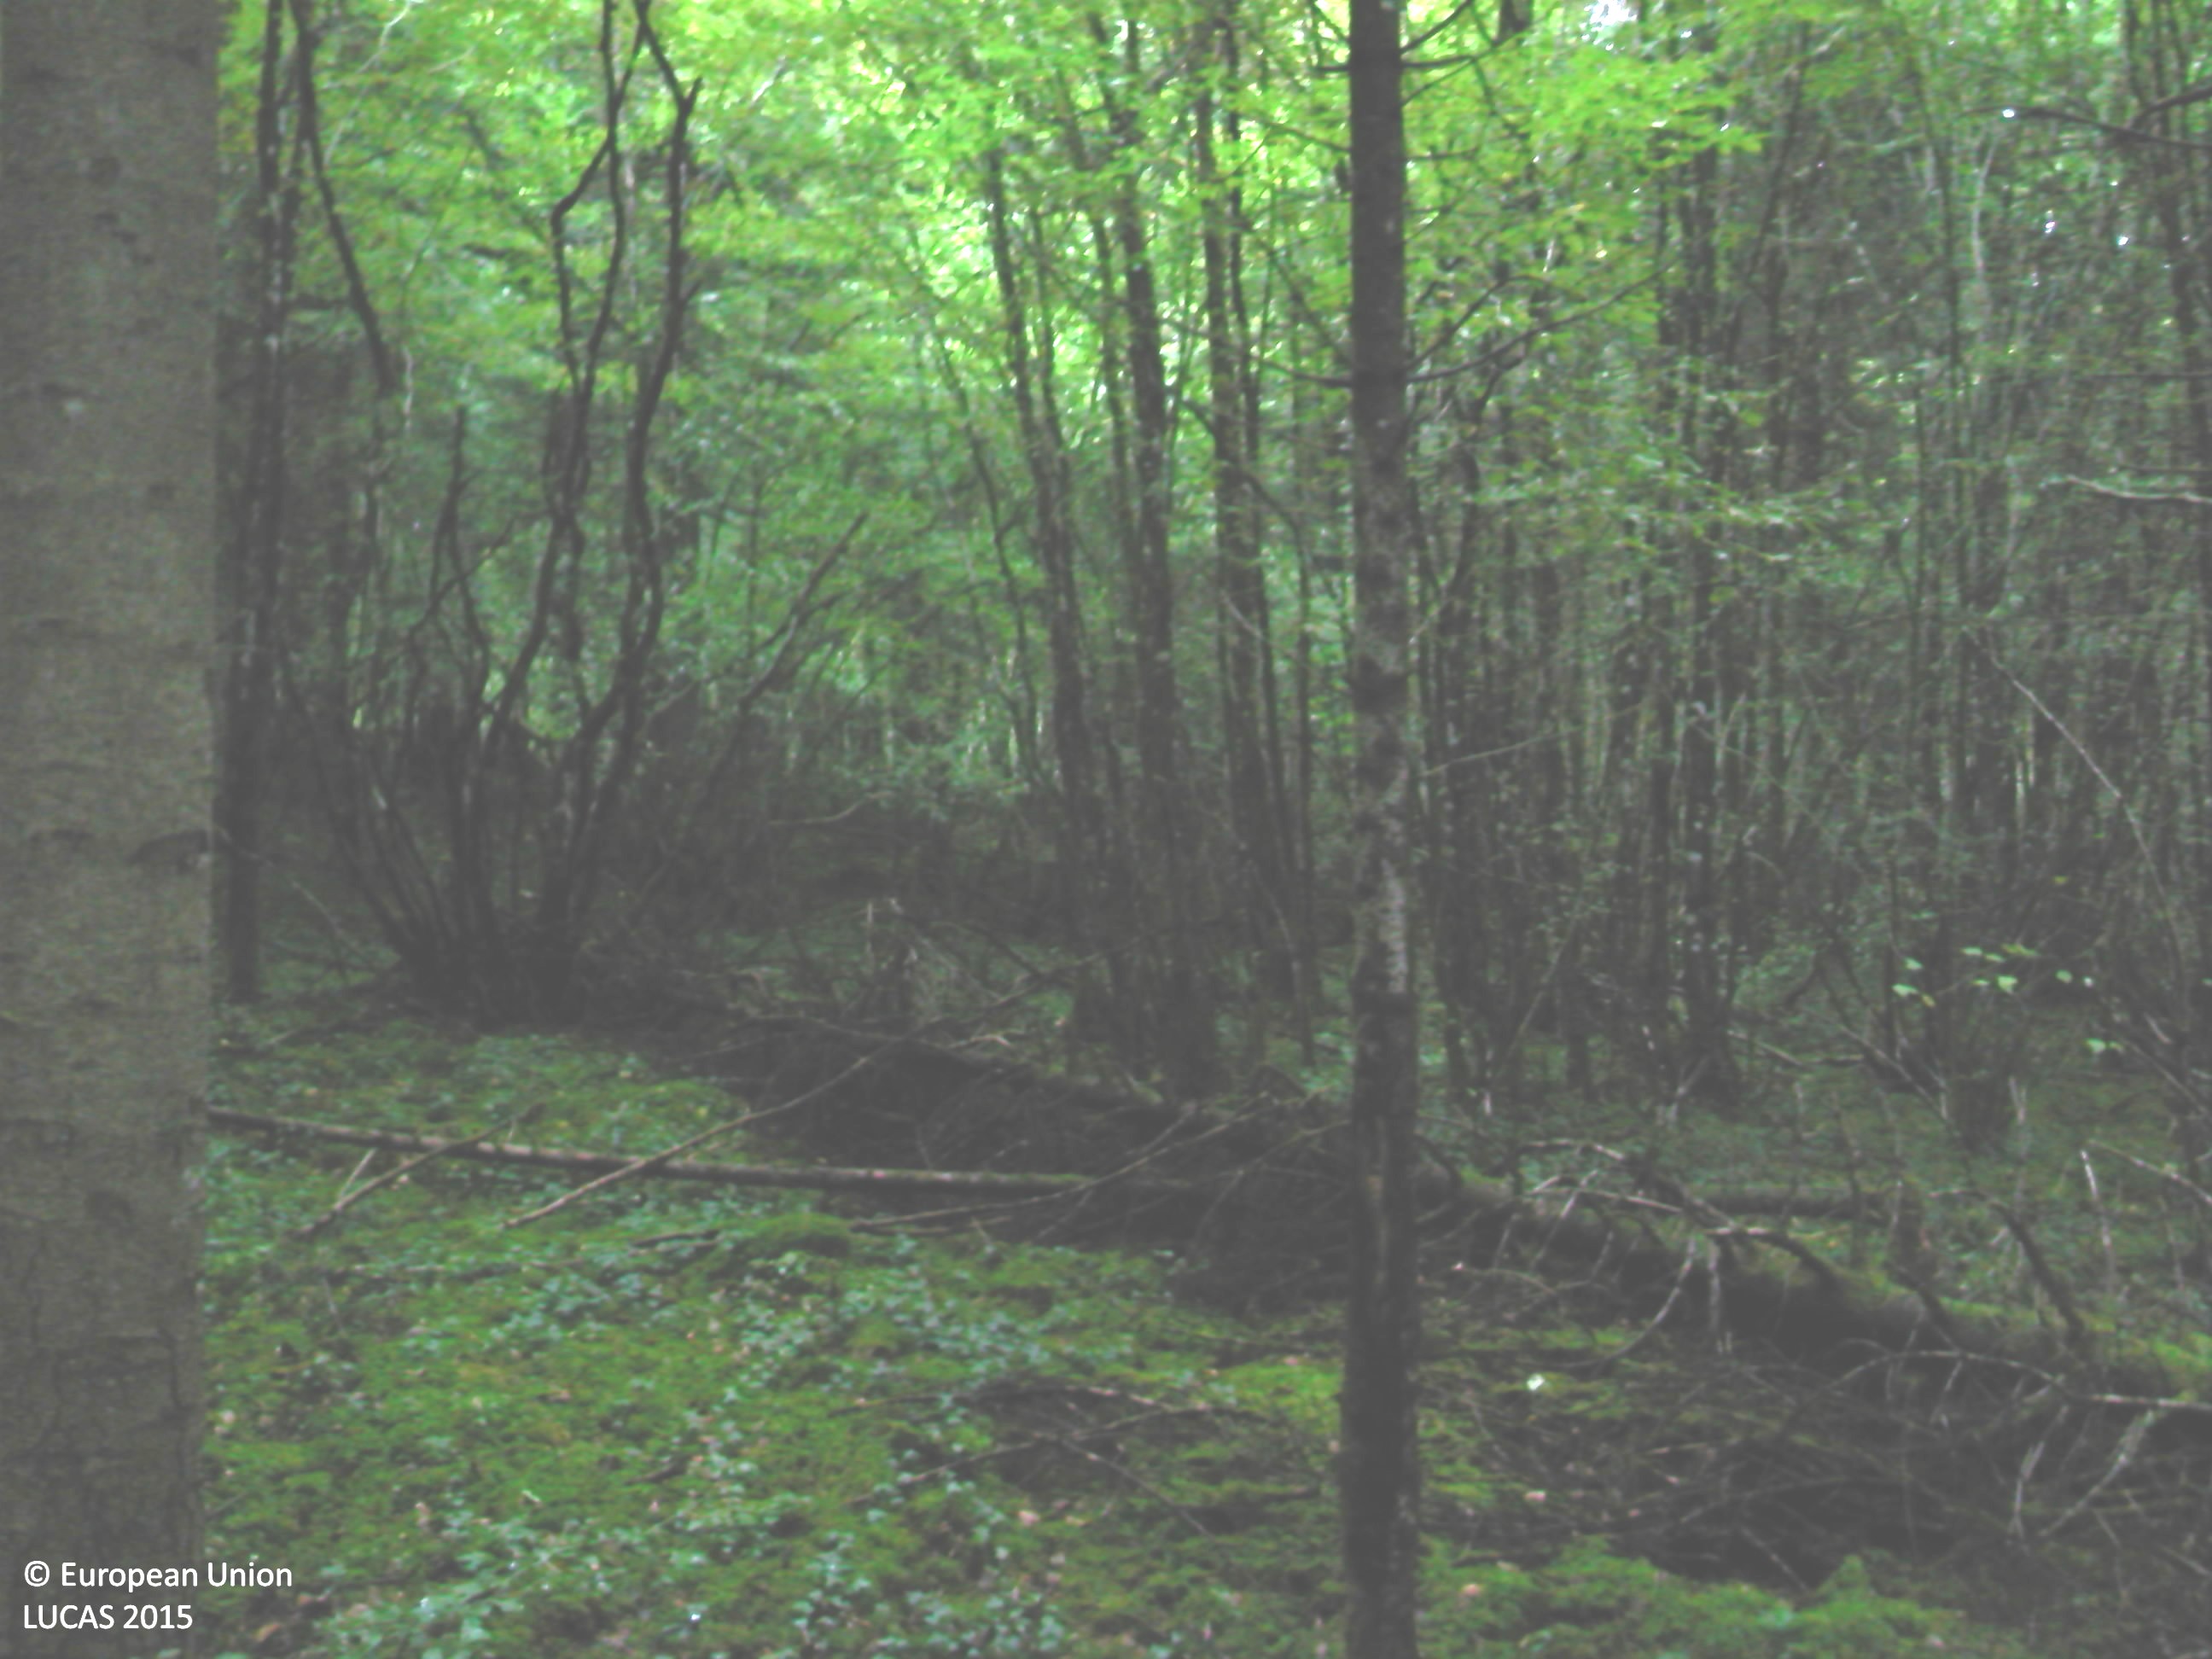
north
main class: Woodland
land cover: Spruce dominated mixed woodland
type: hemiboreal forest and nemoral coniferous forest and mixed broadleaved-coniferous forest
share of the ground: > 75 %
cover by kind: coniferous forest trees 40 %, broadleaved forest trees 40 %, lichens and mosses 15 %, herbaceous plants 5 %
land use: Forestry
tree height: > 5 m
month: September
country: FR
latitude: 48.0228
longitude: 4.6753
